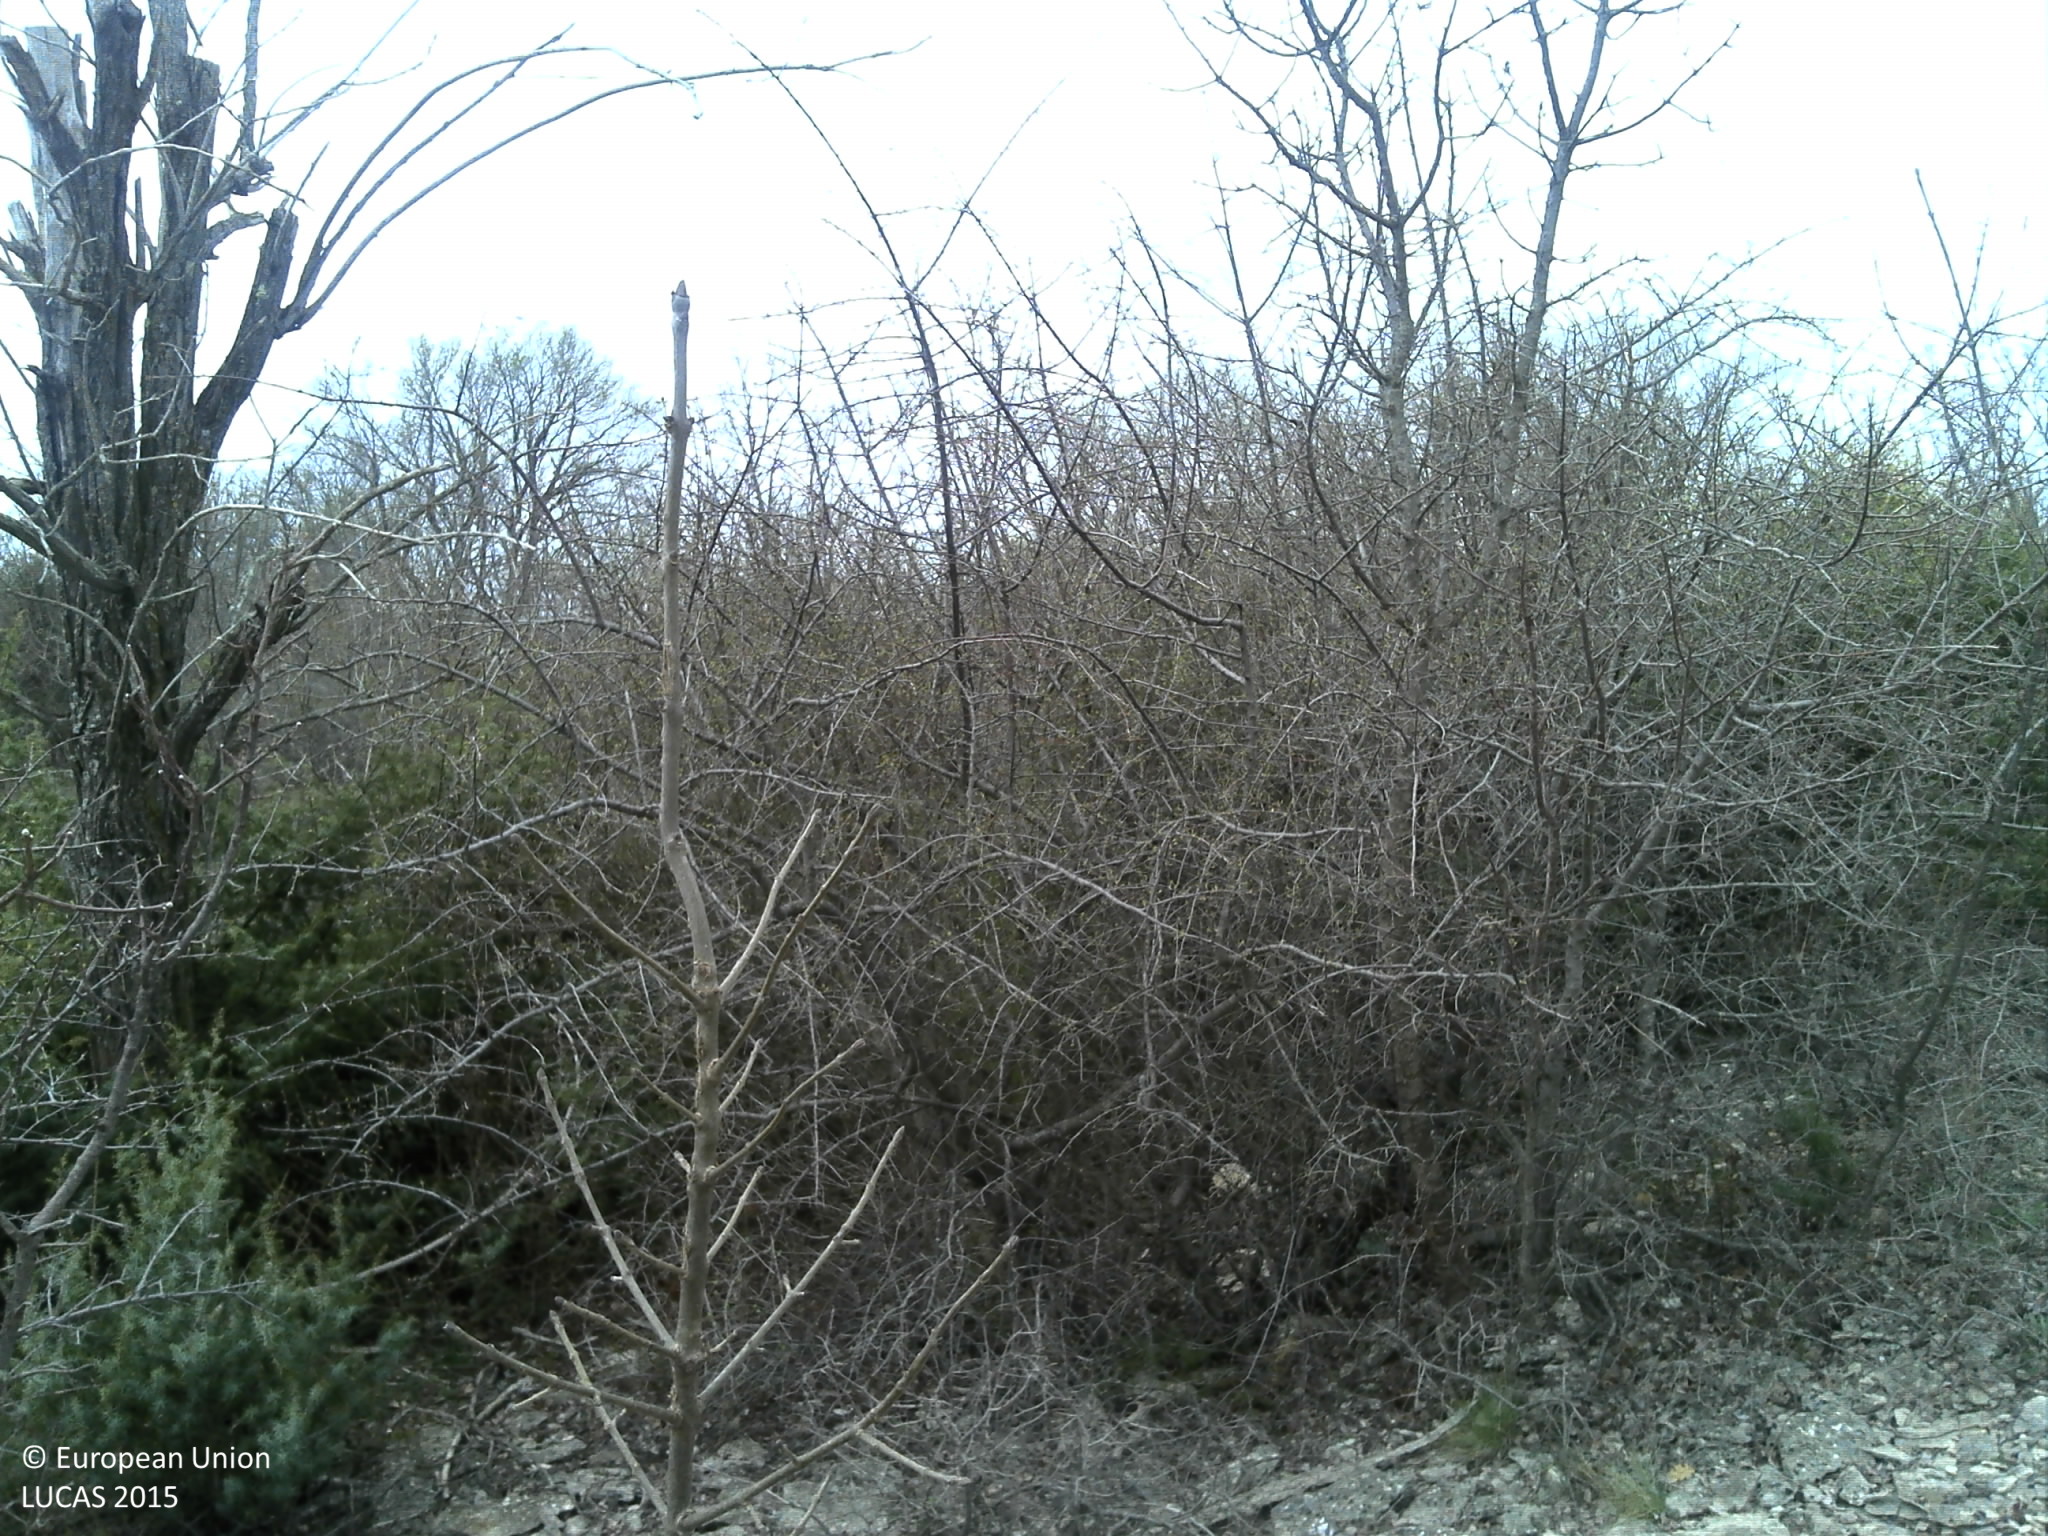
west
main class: Woodland
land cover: Broadleaved woodland
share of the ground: 25 - 50 %
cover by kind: unconsolidated bare surface 35 %, broadleaved forest trees 25 %, shrubs 25 %, herbaceous plants 15 %
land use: Semi-natural and natural areas not in use
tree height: < 5 m
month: March
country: HR
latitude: 43.9872
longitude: 15.8395
